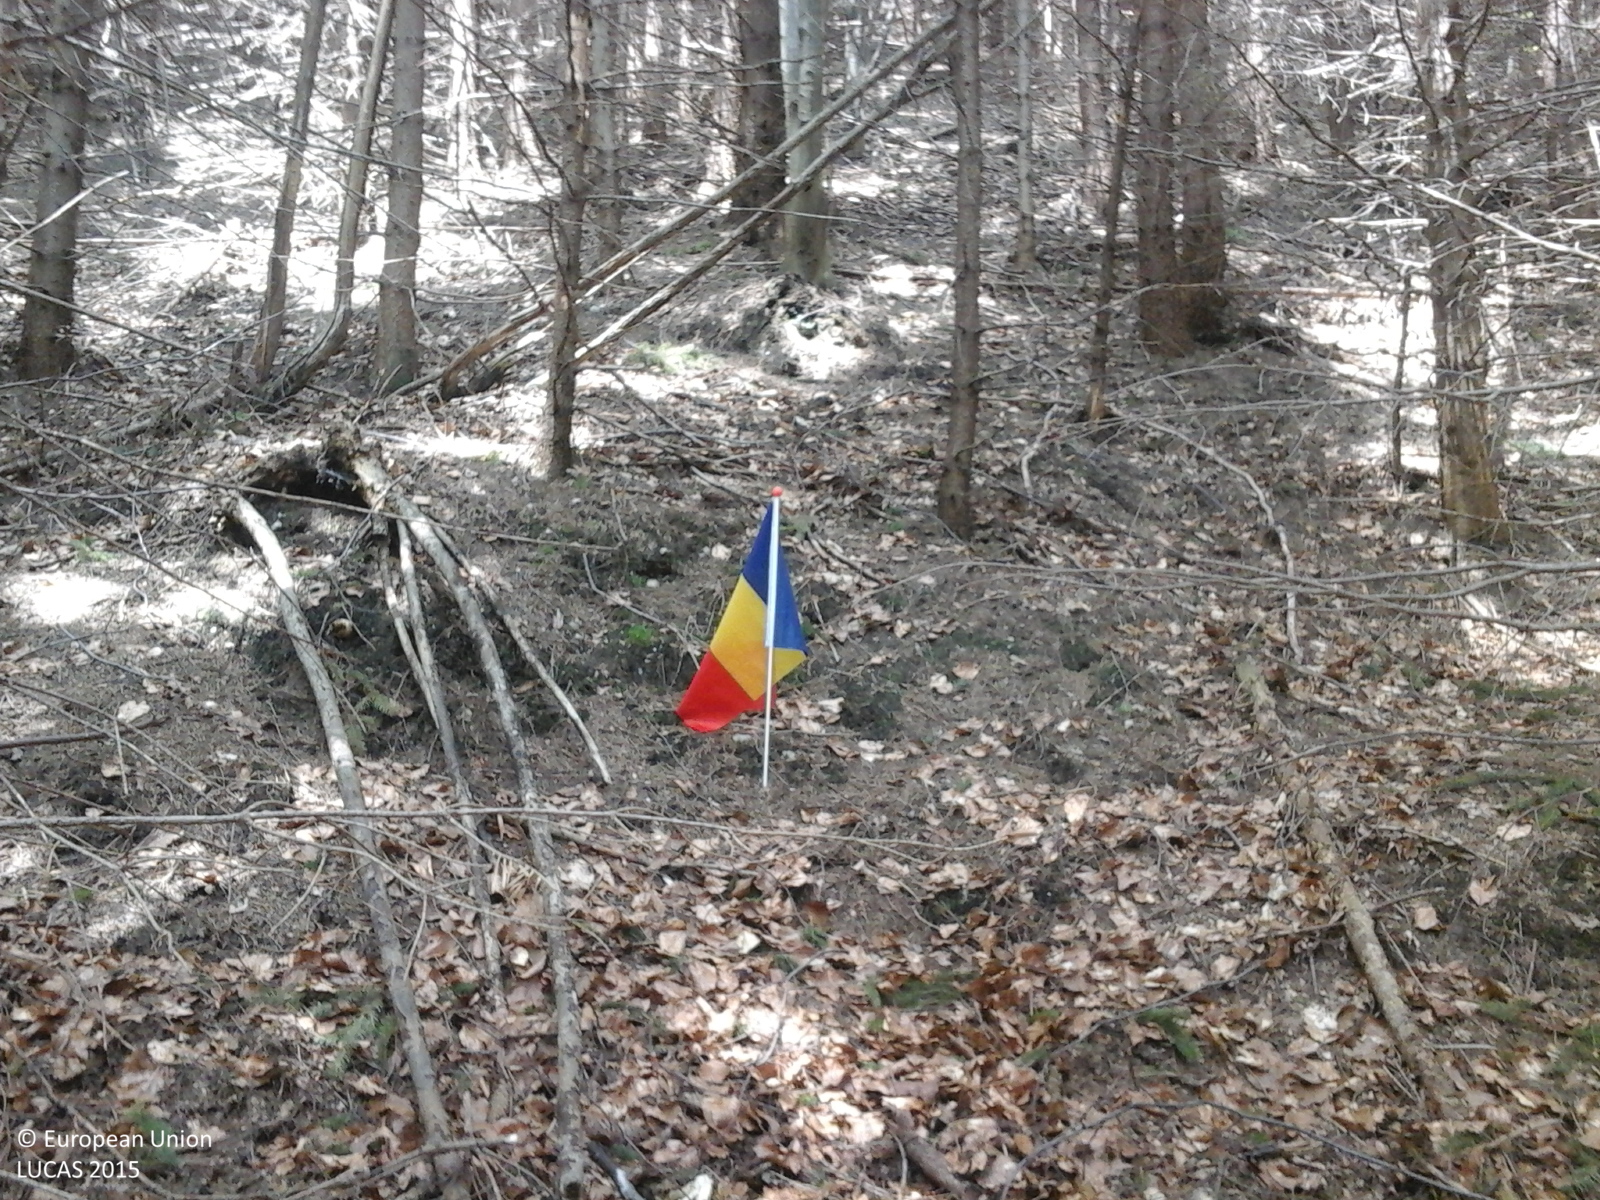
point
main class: Woodland
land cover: Spruce dominated mixed woodland
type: alpine coniferous forest
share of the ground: > 75 %
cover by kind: coniferous forest trees 50 %, broadleaved forest trees 50 %
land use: Forestry
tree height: > 5 m
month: May
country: RO
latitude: 45.5686
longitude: 25.9362
